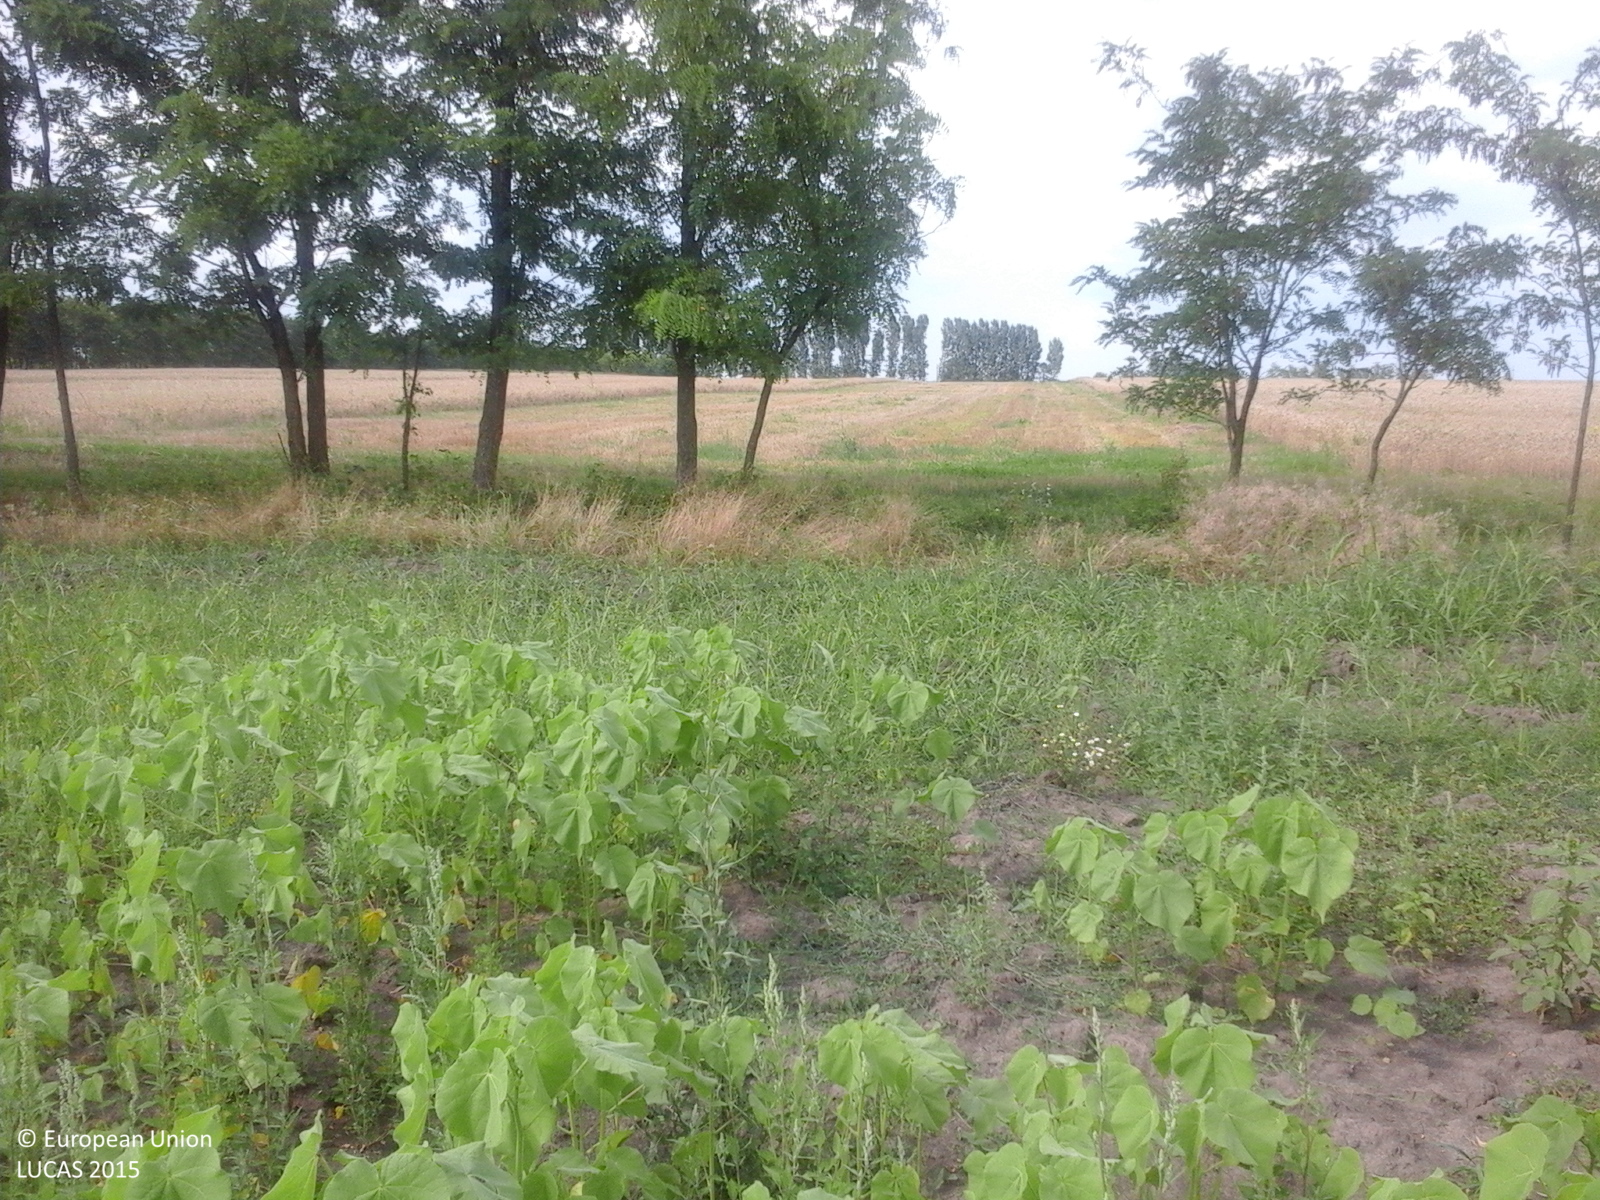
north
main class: Cropland
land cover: Sunflower
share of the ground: > 75 %
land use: Agriculture (excluding fallow land and kitchen gardens)
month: July
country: RO
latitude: 43.9815
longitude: 24.2618
